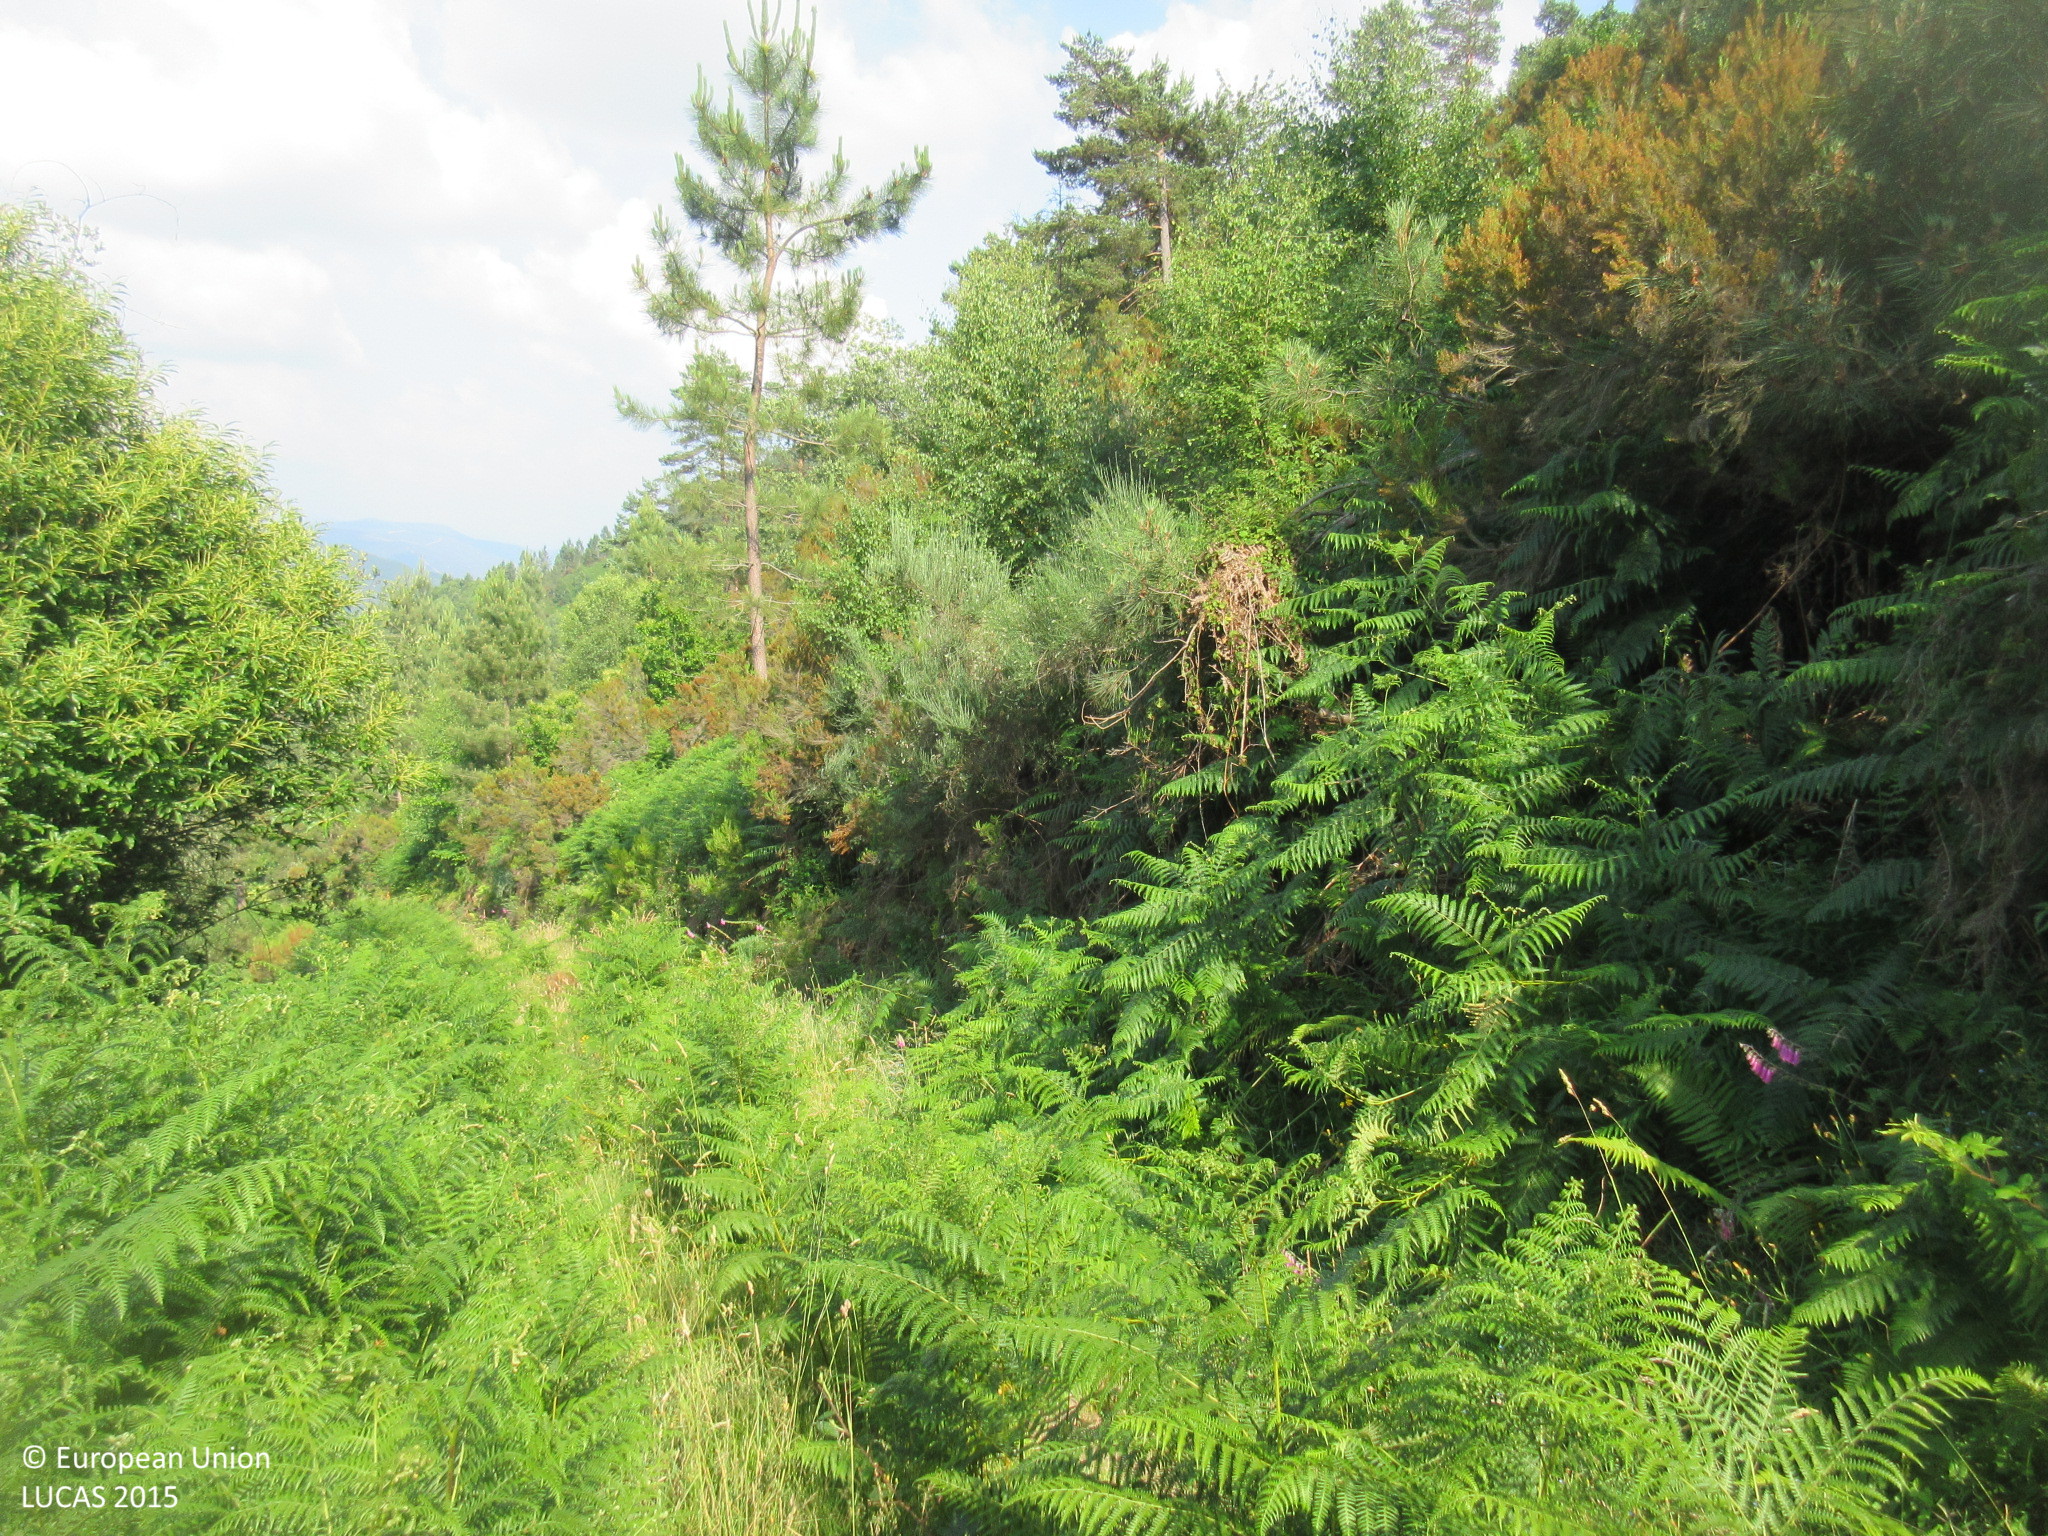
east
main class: Woodland
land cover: Broadleaved woodland
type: acidophilous oak and oak-birch forest
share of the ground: > 75 %
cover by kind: broadleaved forest trees 75 %, shrubs 25 %
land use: Forestry
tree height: > 5 m
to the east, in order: Broadleaved woodland; Tracks; Broadleaved woodland
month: June
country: ES
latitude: 42.9823
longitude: -7.0477
